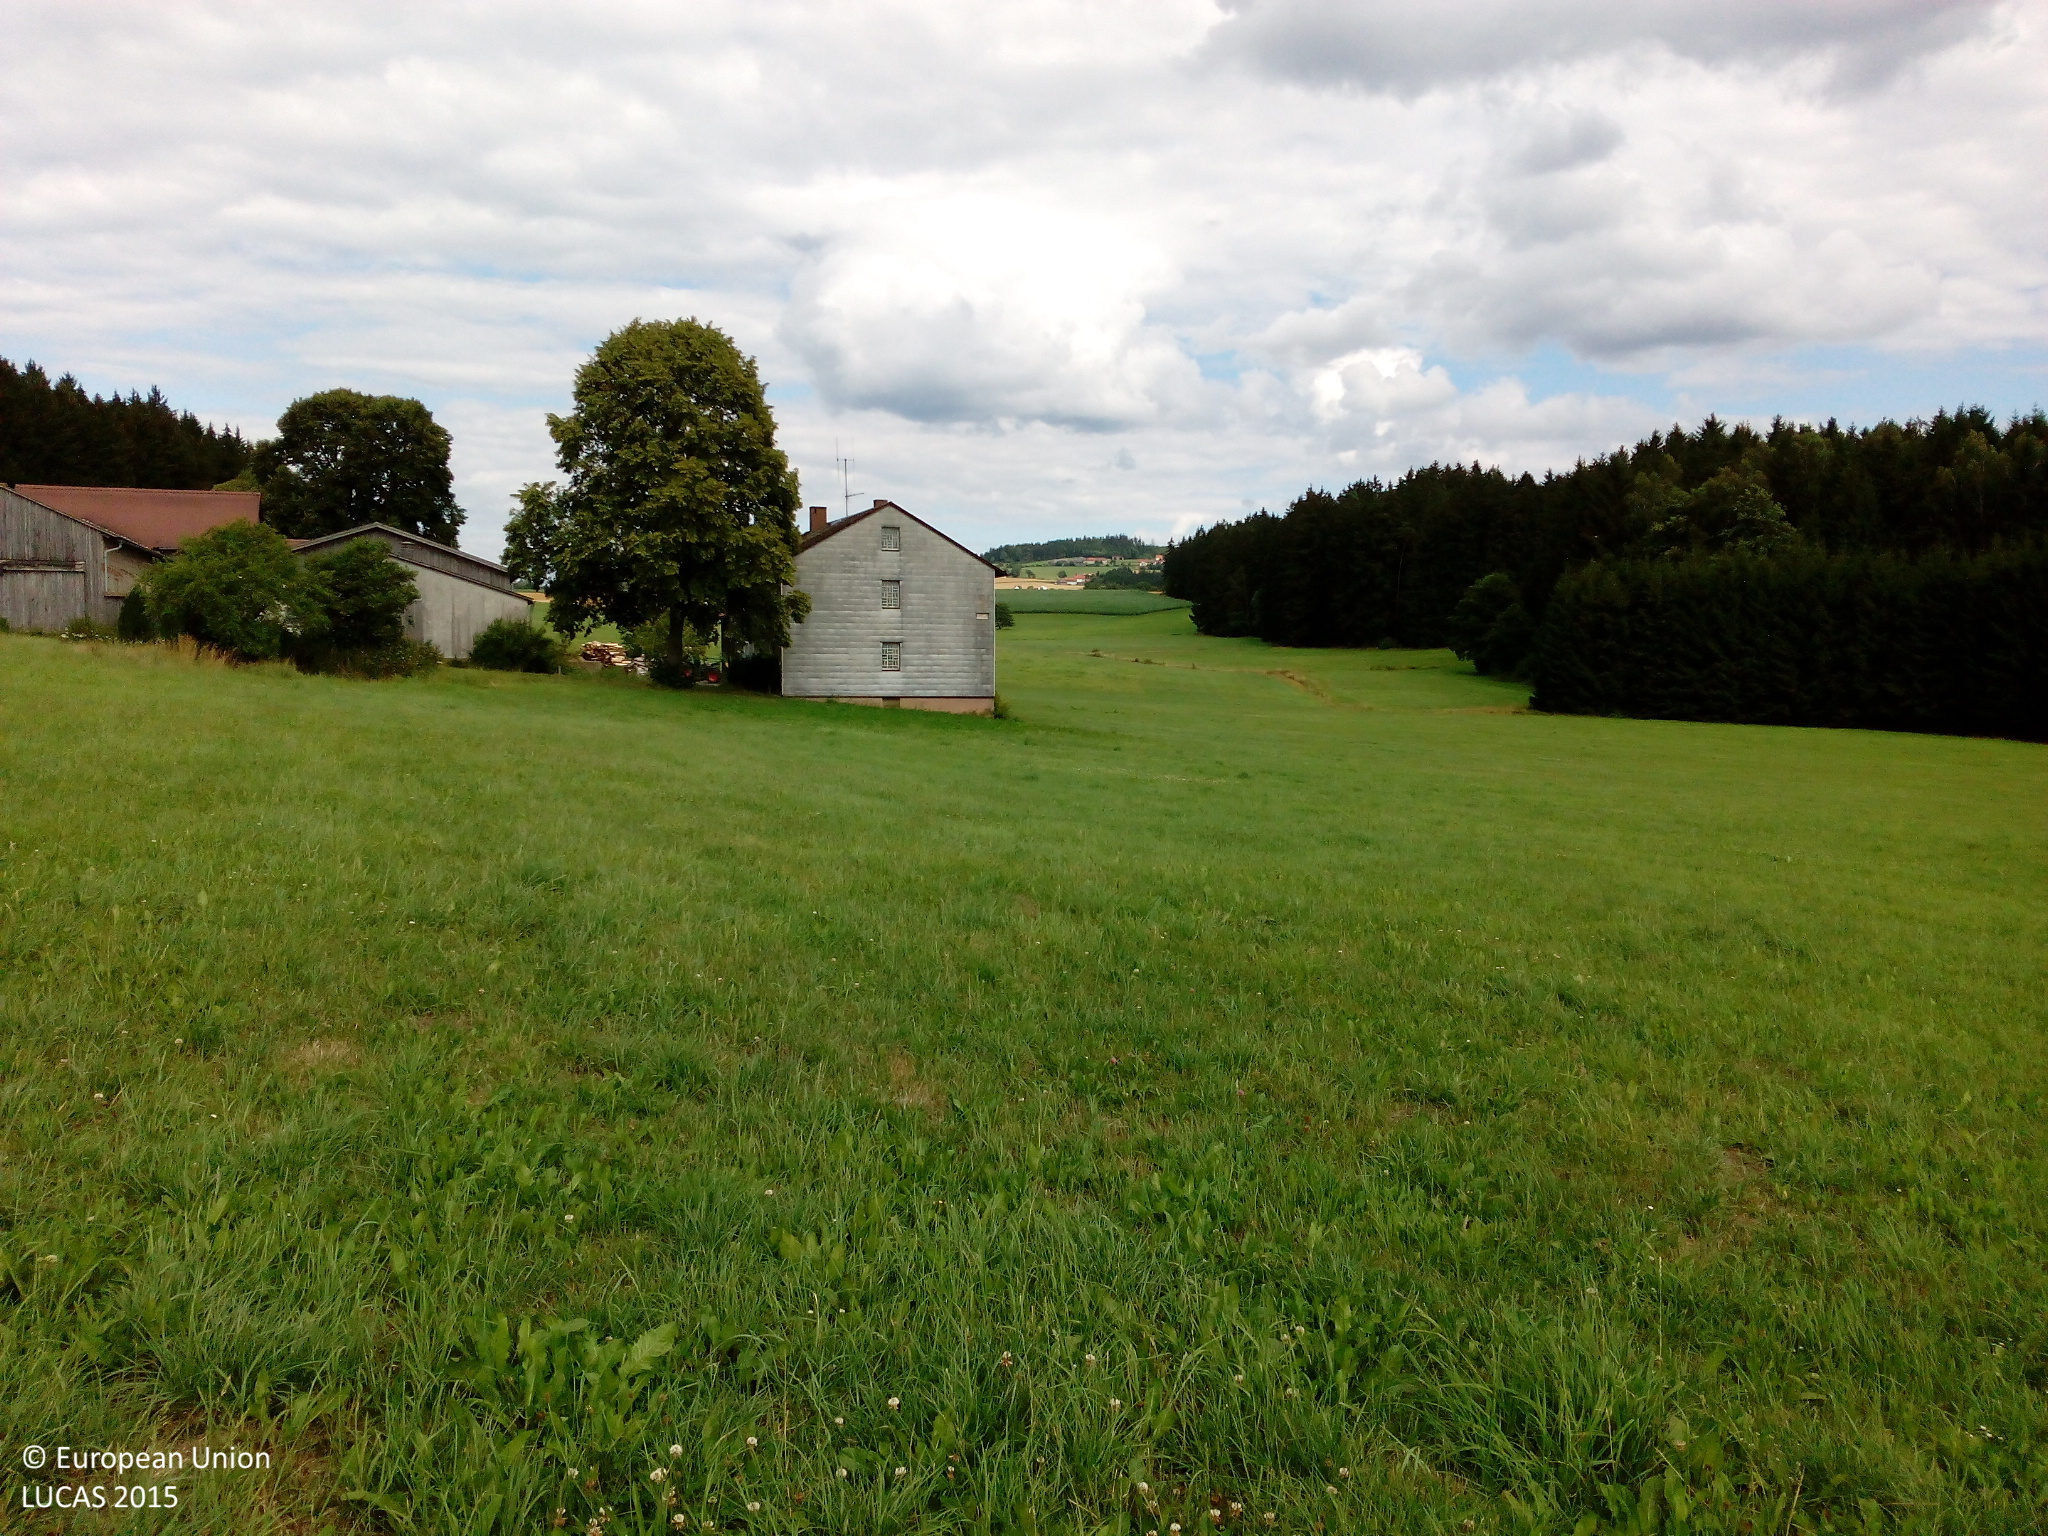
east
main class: Grassland
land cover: Grassland without tree/shrub cover
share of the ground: > 75 %
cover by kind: herbaceous plants 100 %
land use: Agriculture (excluding fallow land and kitchen gardens)
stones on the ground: < 10 %
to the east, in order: Grassland without tree/shrub cover; Artificial constructions in urban areas; Grassland without tree/shrub cover; Artificial constructions in urban areas; Grassland without tree/shrub cover
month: July
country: DE
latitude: 49.8530
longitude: 12.4058
